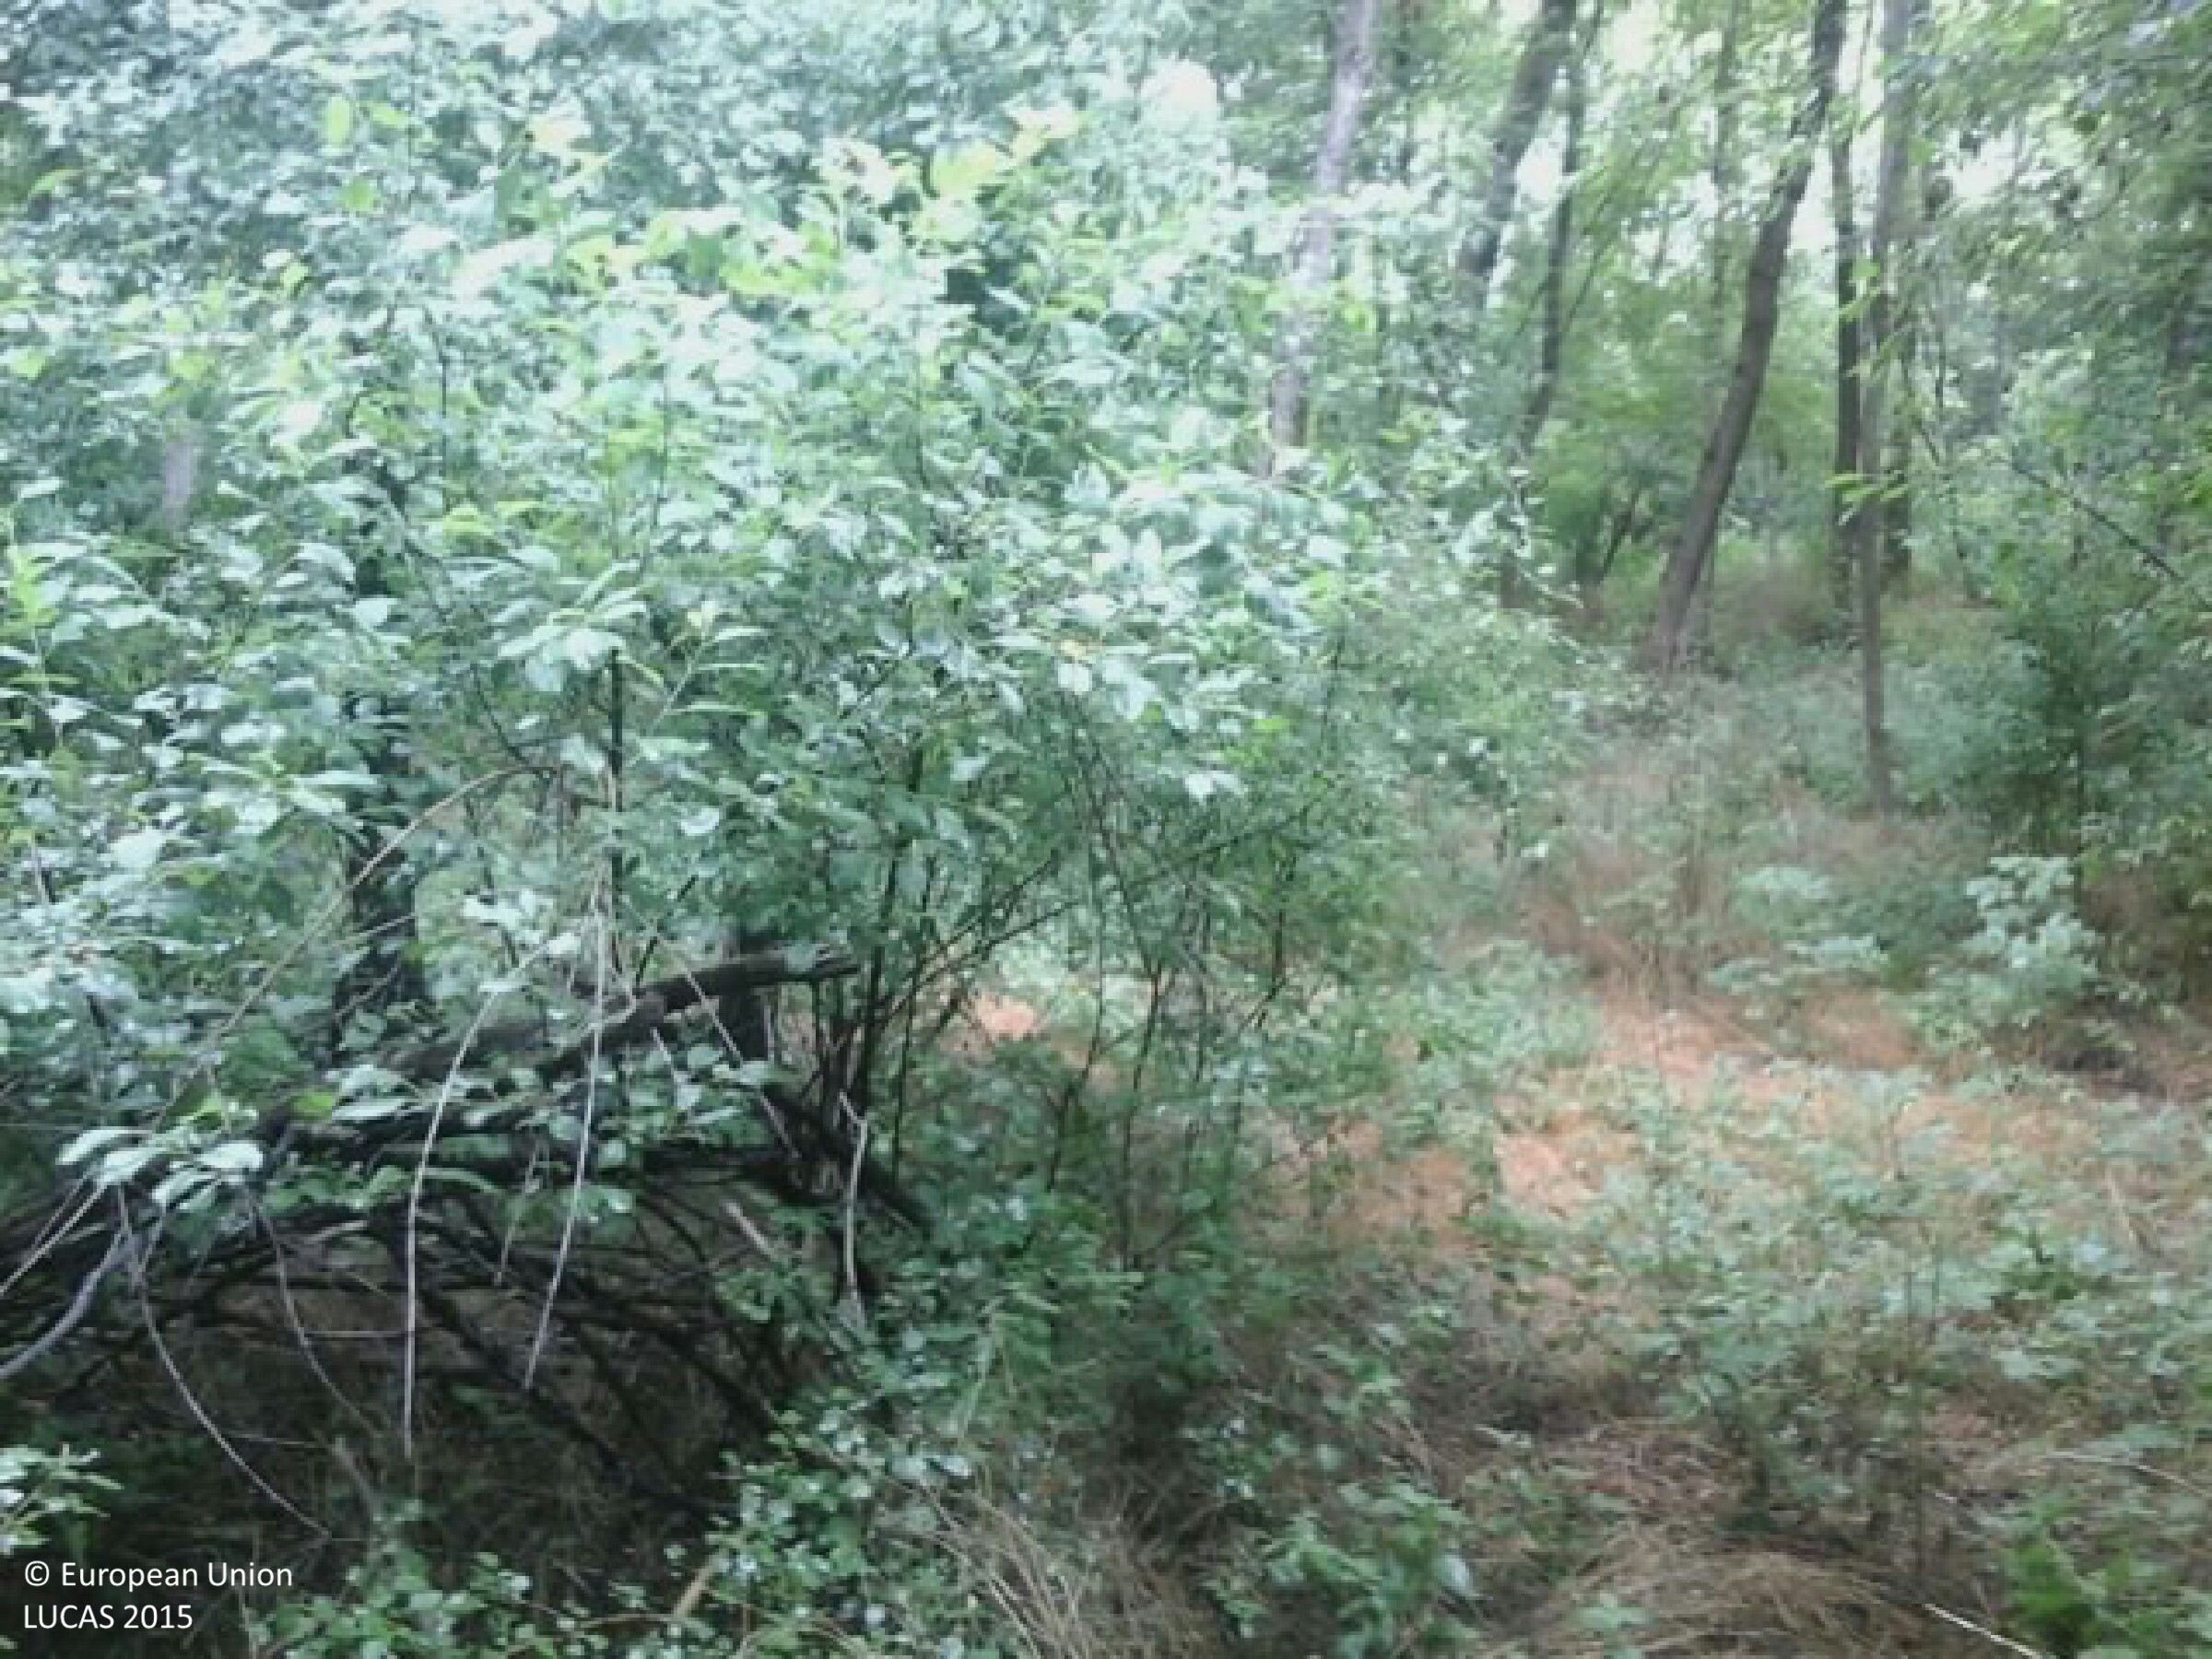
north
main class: Woodland
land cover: Broadleaved woodland
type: mesophytic deciduous forest
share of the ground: > 75 %
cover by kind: broadleaved forest trees 80 %, herbaceous plants 20 %
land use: Forestry
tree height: > 5 m
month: June
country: HU
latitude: 46.2429
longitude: 19.0003
